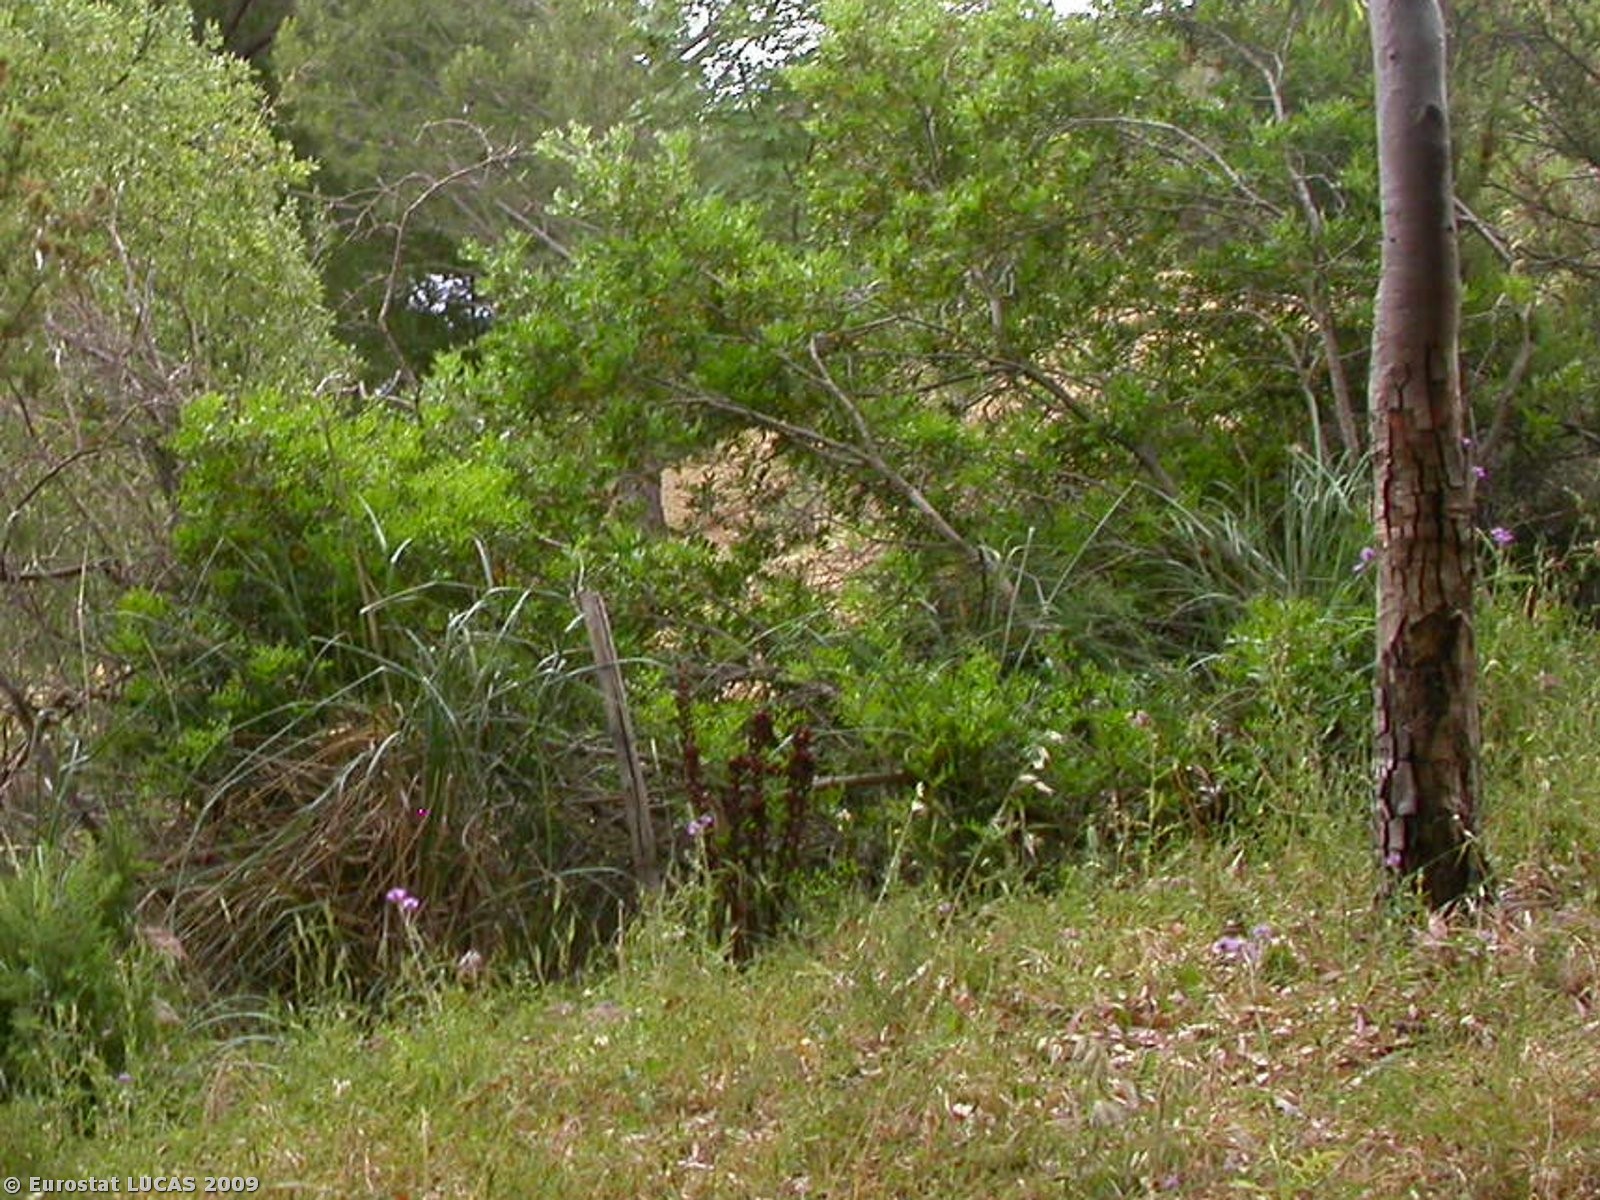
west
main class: Woodland
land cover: Coniferous woodland
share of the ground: > 75 %
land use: Forestry
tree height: > 5 m
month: June
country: IT
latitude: 38.0051
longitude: 14.0830
